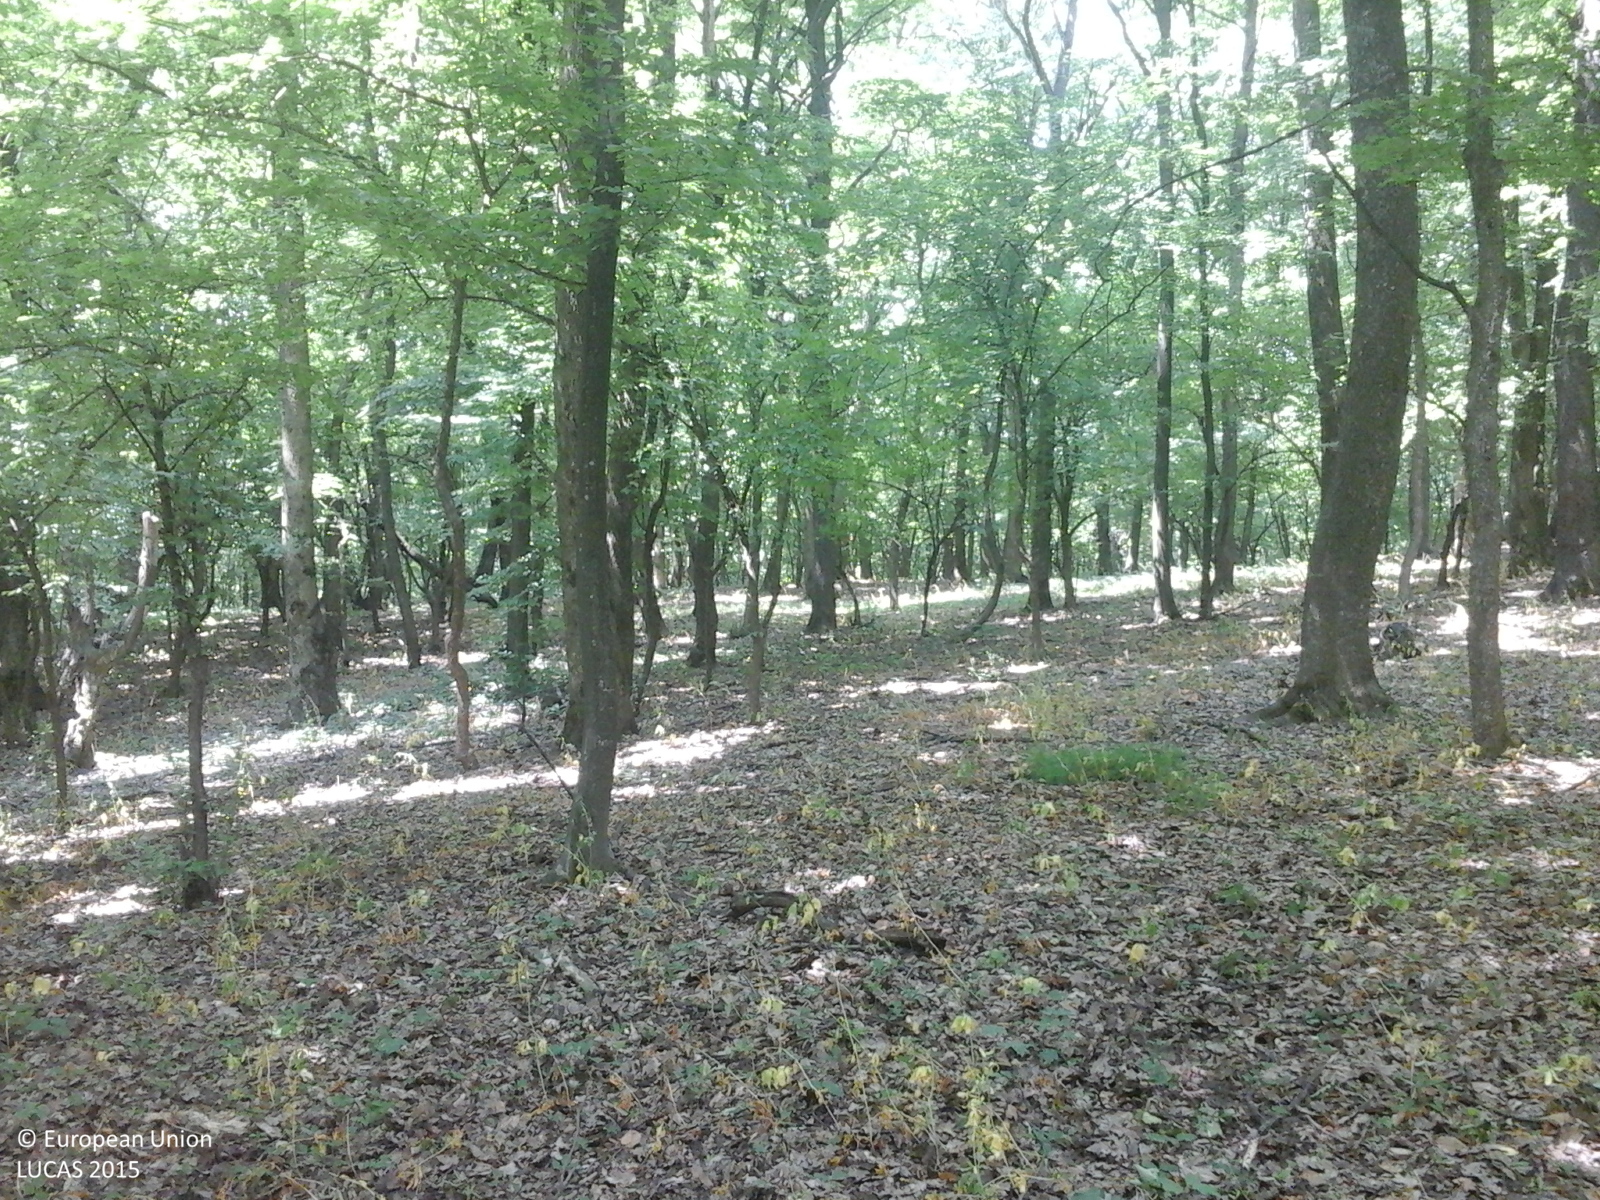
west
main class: Woodland
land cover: Broadleaved woodland
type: mesophytic deciduous forest
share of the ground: > 75 %
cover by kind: broadleaved forest trees 100 %
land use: Forestry
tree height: > 5 m
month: June
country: RO
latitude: 46.3707
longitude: 27.1413
